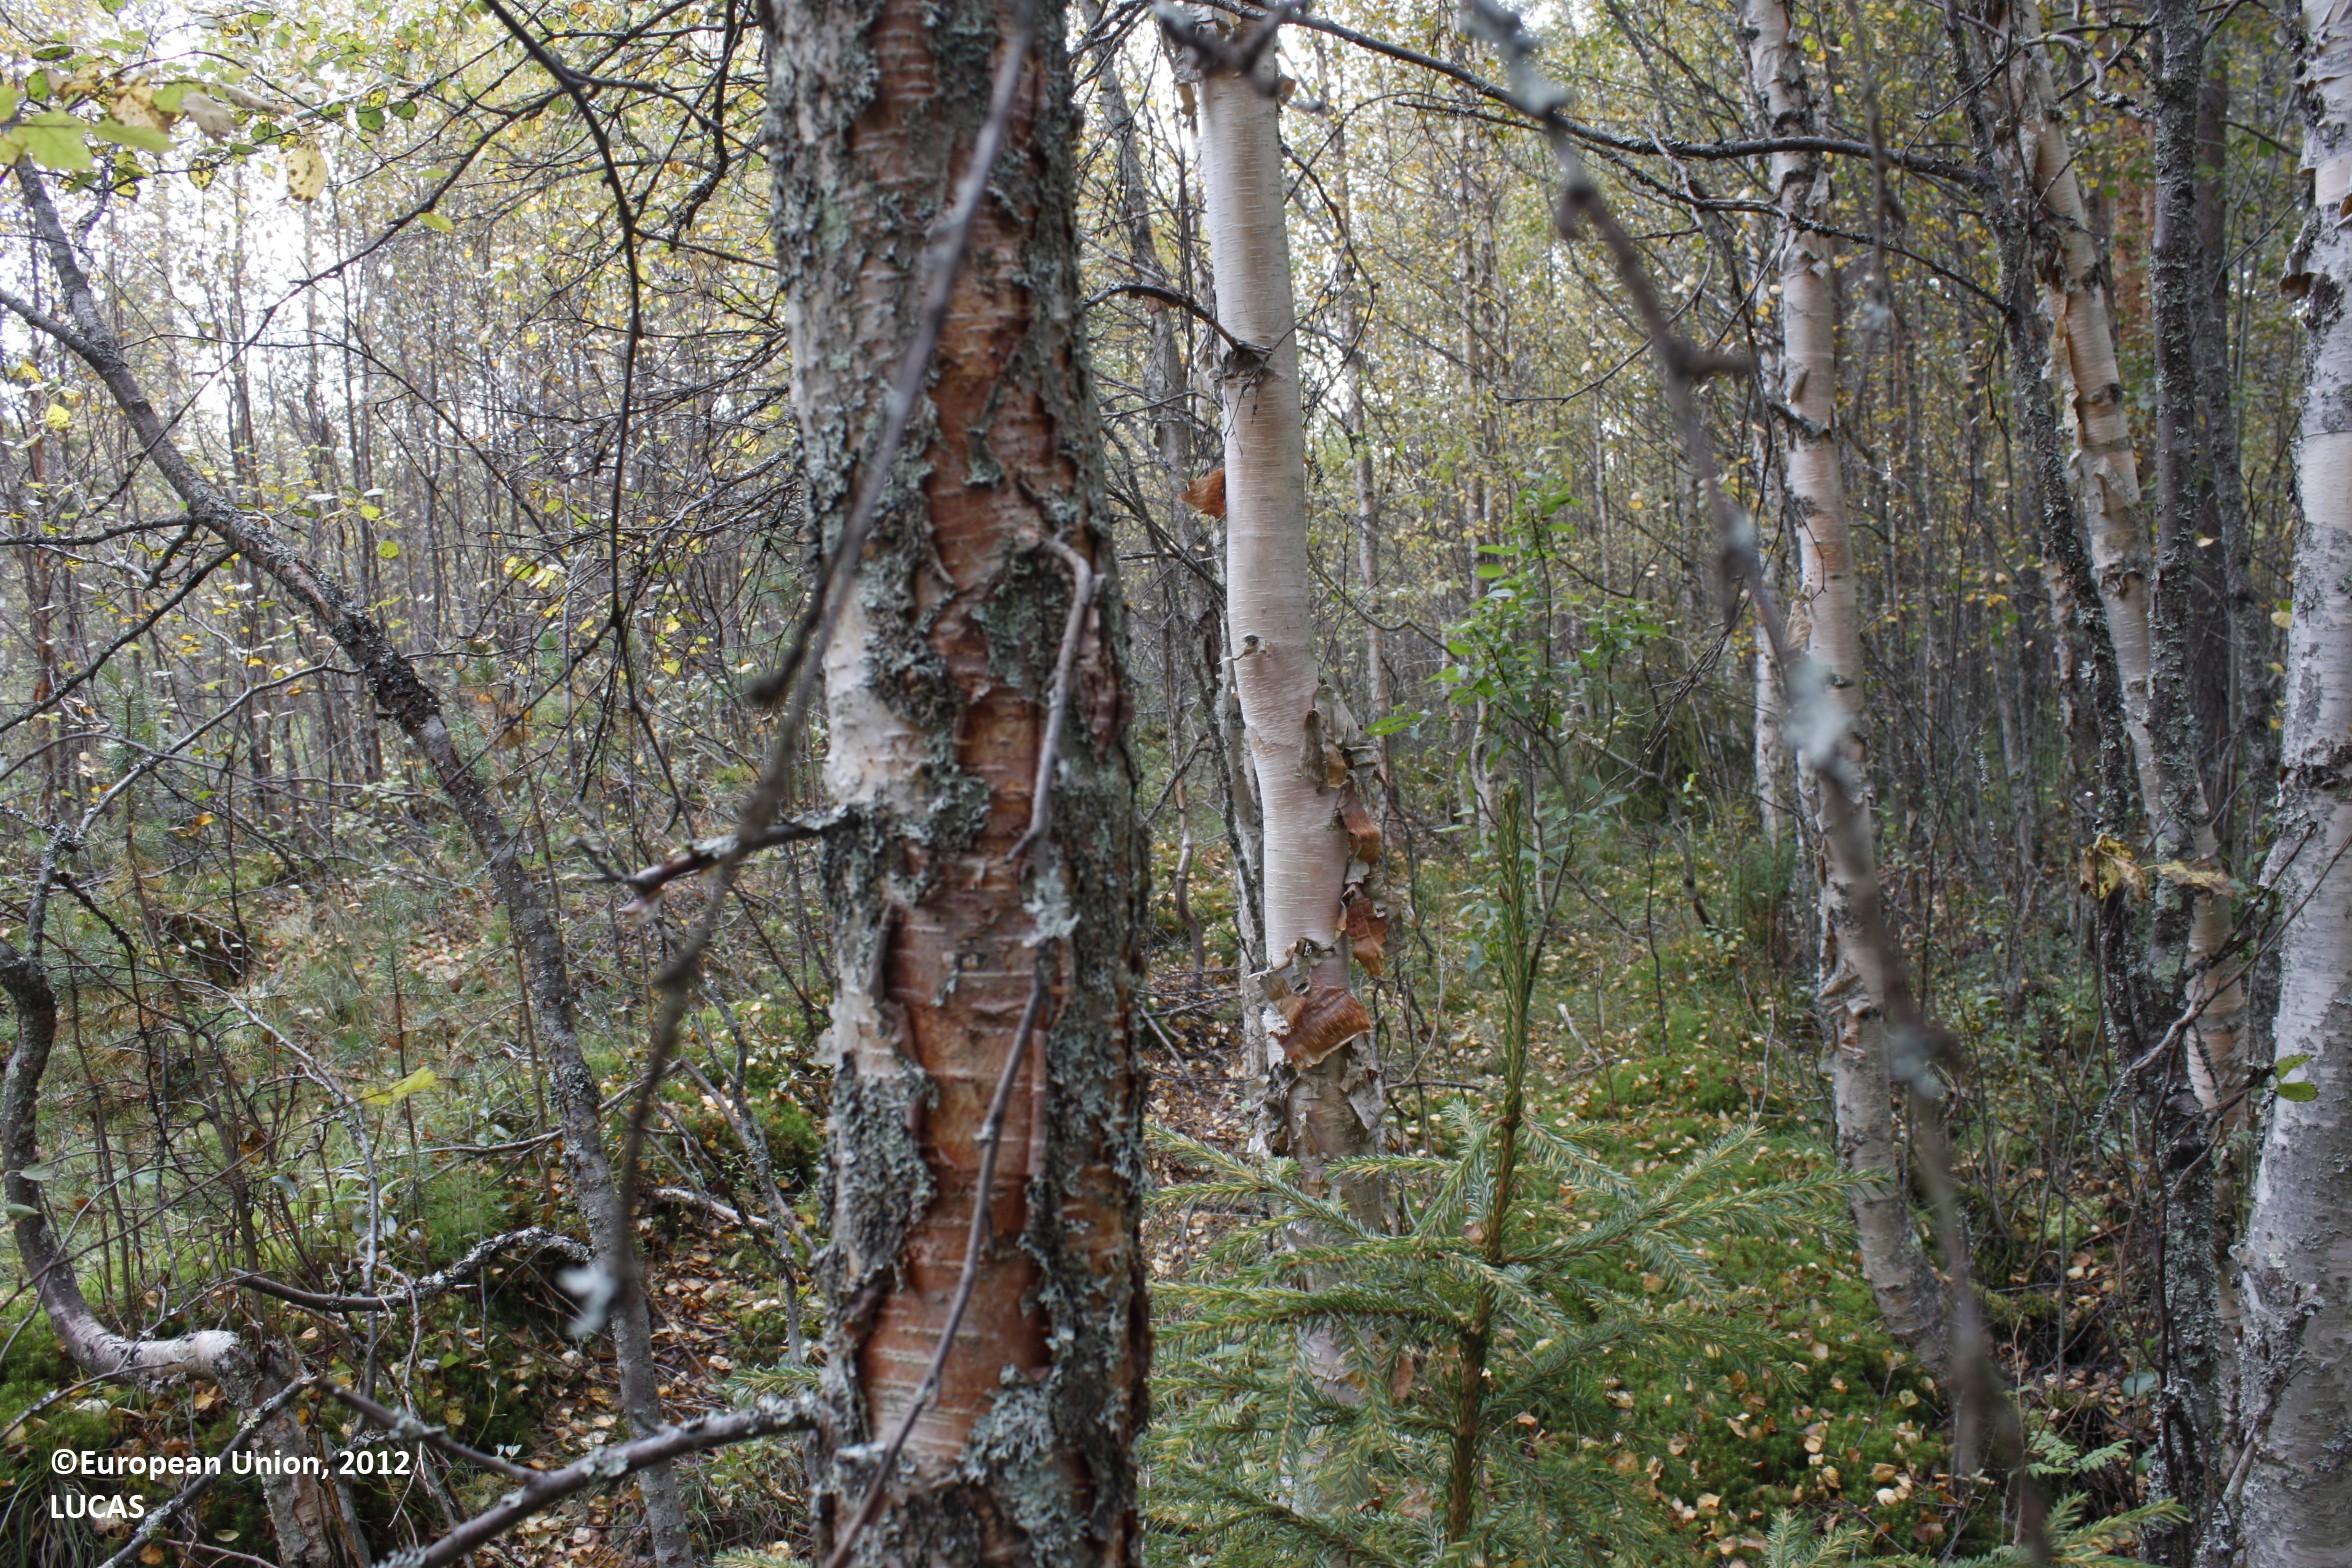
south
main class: Woodland
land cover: Pine dominated mixed woodland
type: boreal forest
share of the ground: > 75 %
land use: Forestry
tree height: > 5 m
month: September
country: FI
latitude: 65.3841
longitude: 27.0066
